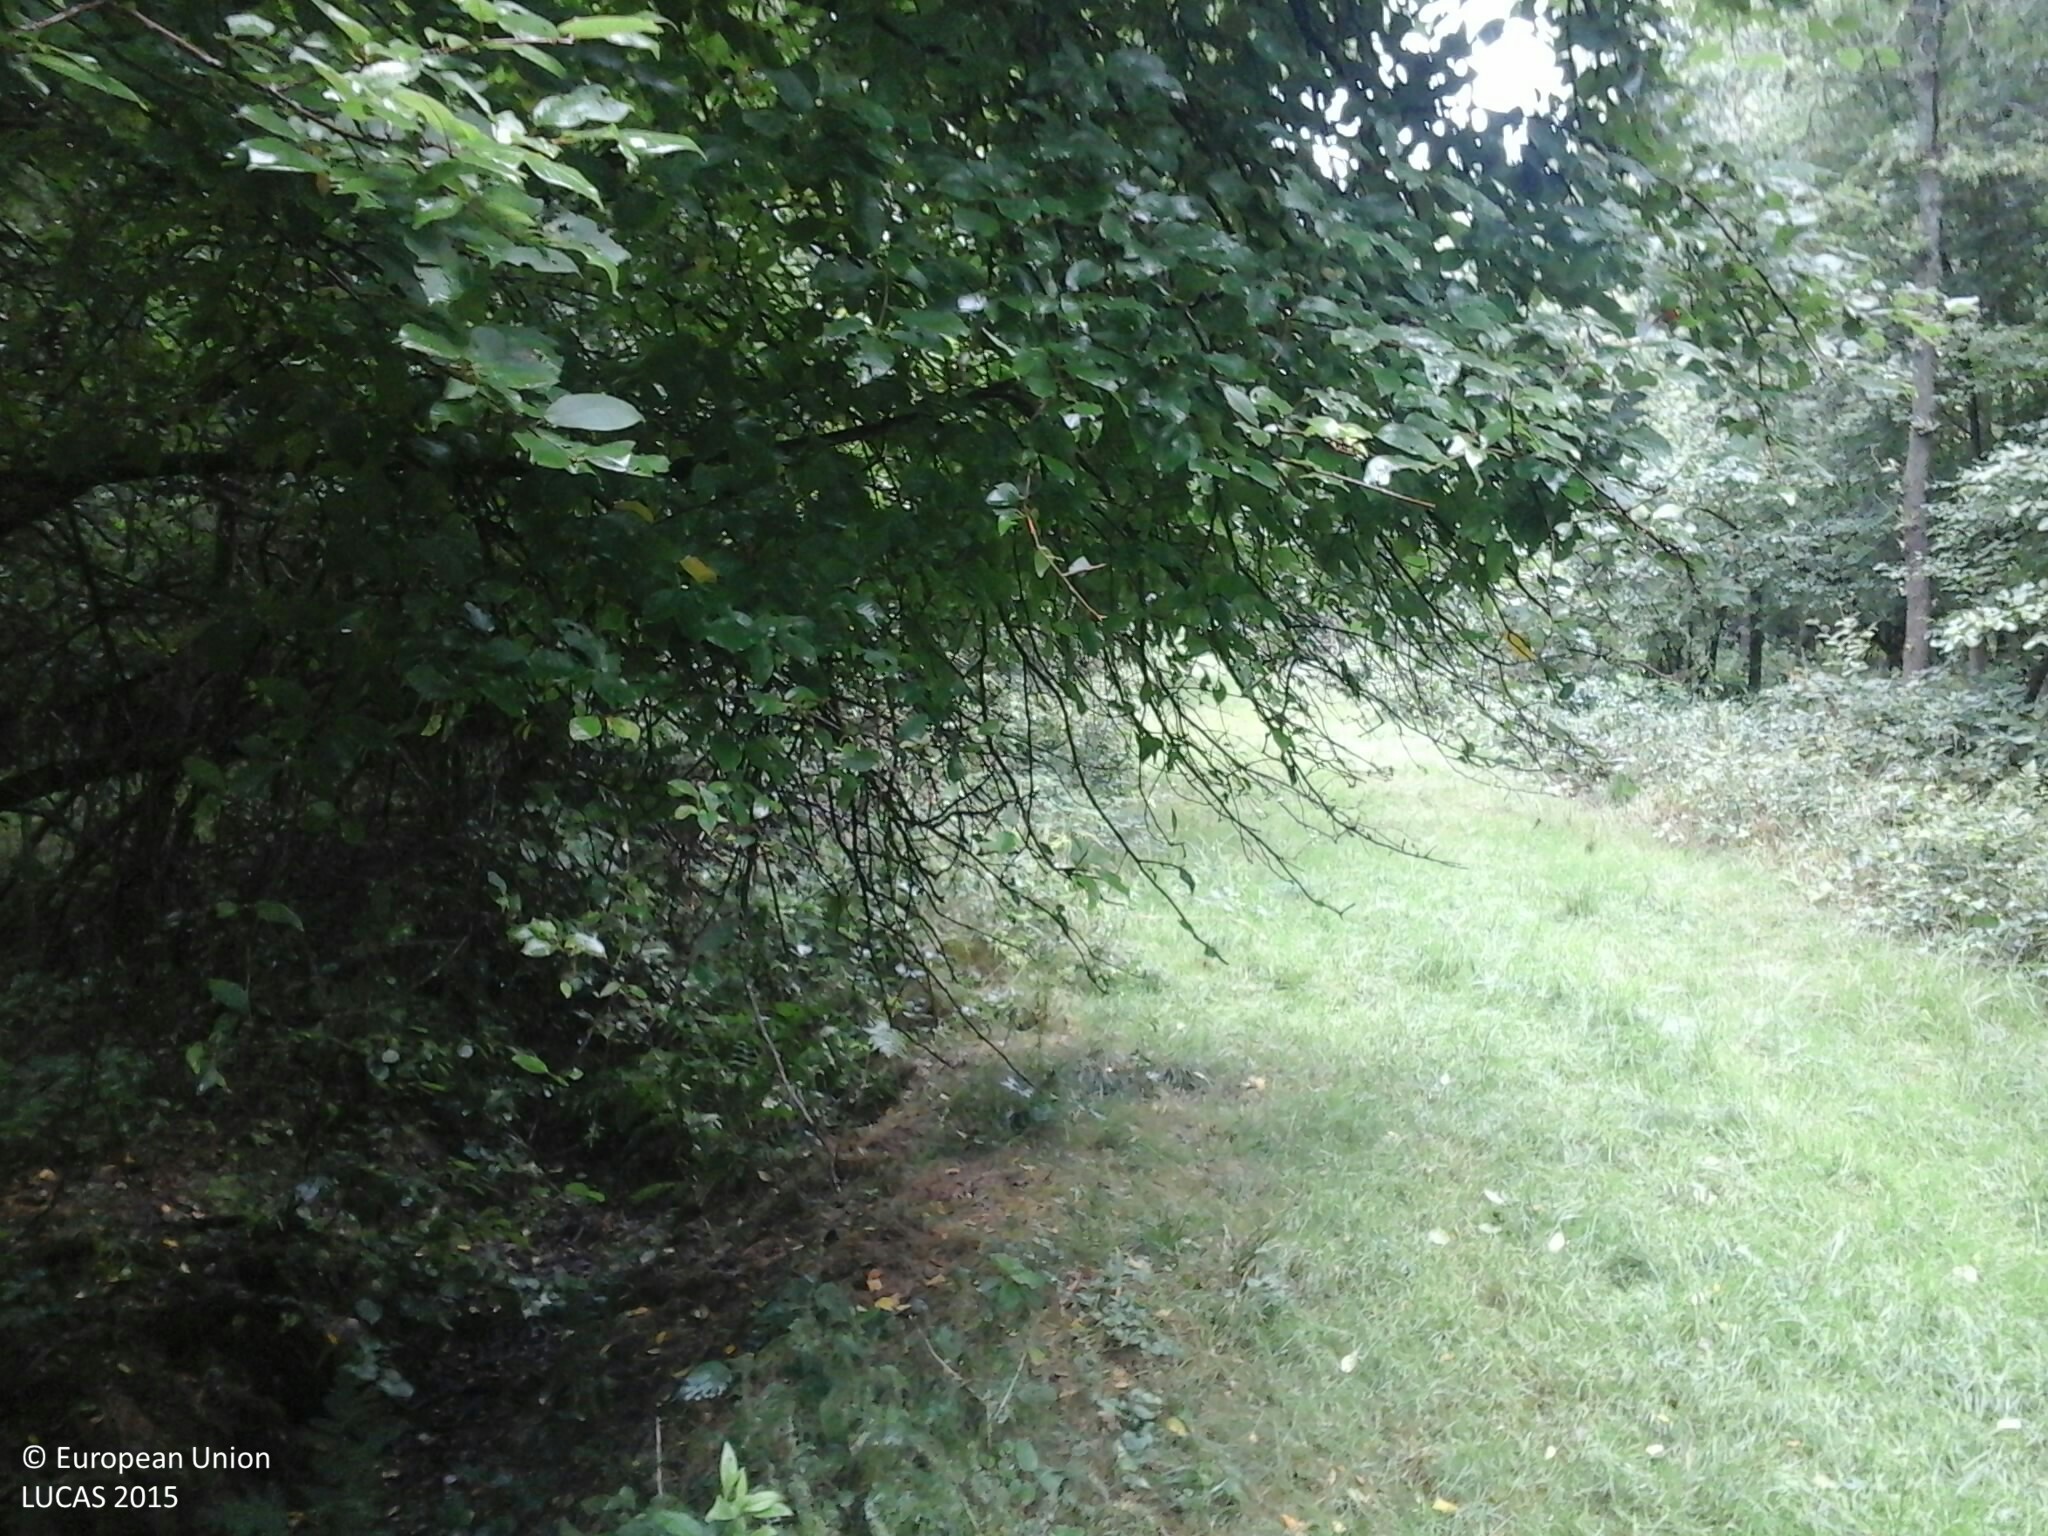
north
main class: Woodland
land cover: Broadleaved woodland
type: mesophytic deciduous forest
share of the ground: > 75 %
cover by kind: broadleaved forest trees 75 %, herbaceous plants 15 %, shrubs 10 %
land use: Forestry
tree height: > 5 m
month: July
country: HU
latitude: 46.9121
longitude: 16.5015
